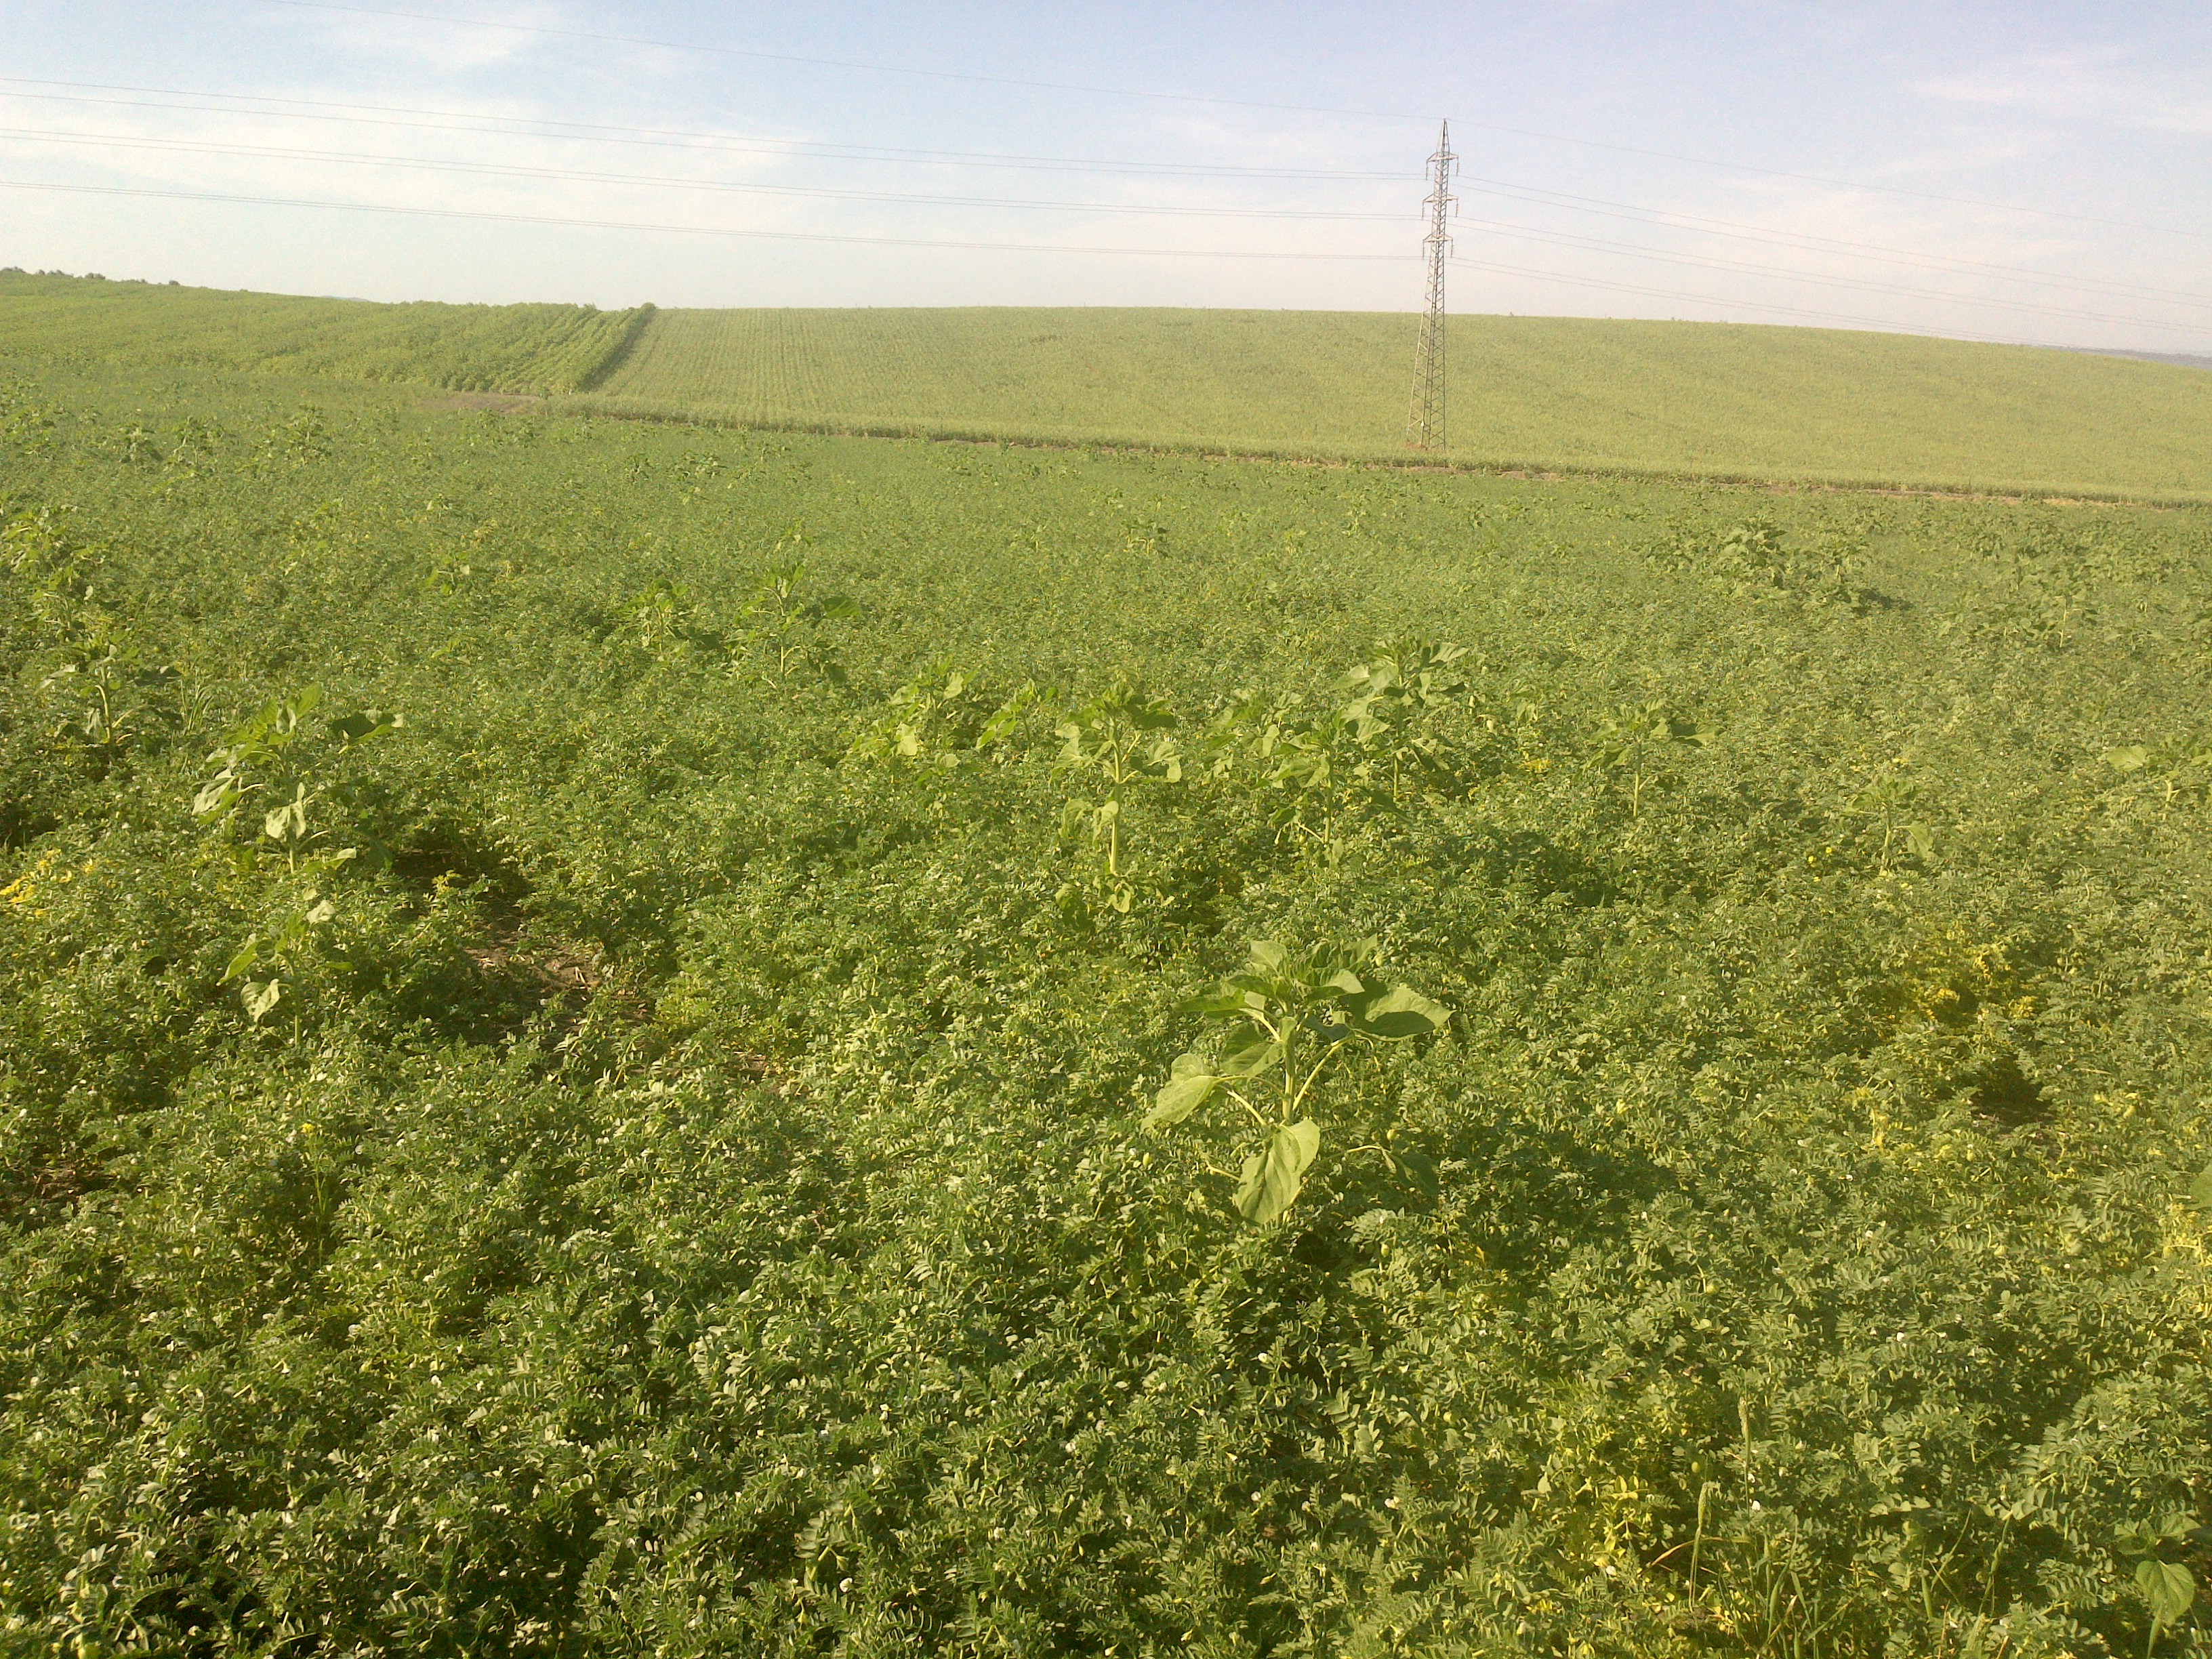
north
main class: Cropland
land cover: Dry pulses
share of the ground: > 75 %
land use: Agriculture (excluding fallow land and kitchen gardens)
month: May
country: ES
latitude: 37.9042
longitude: -4.5811
